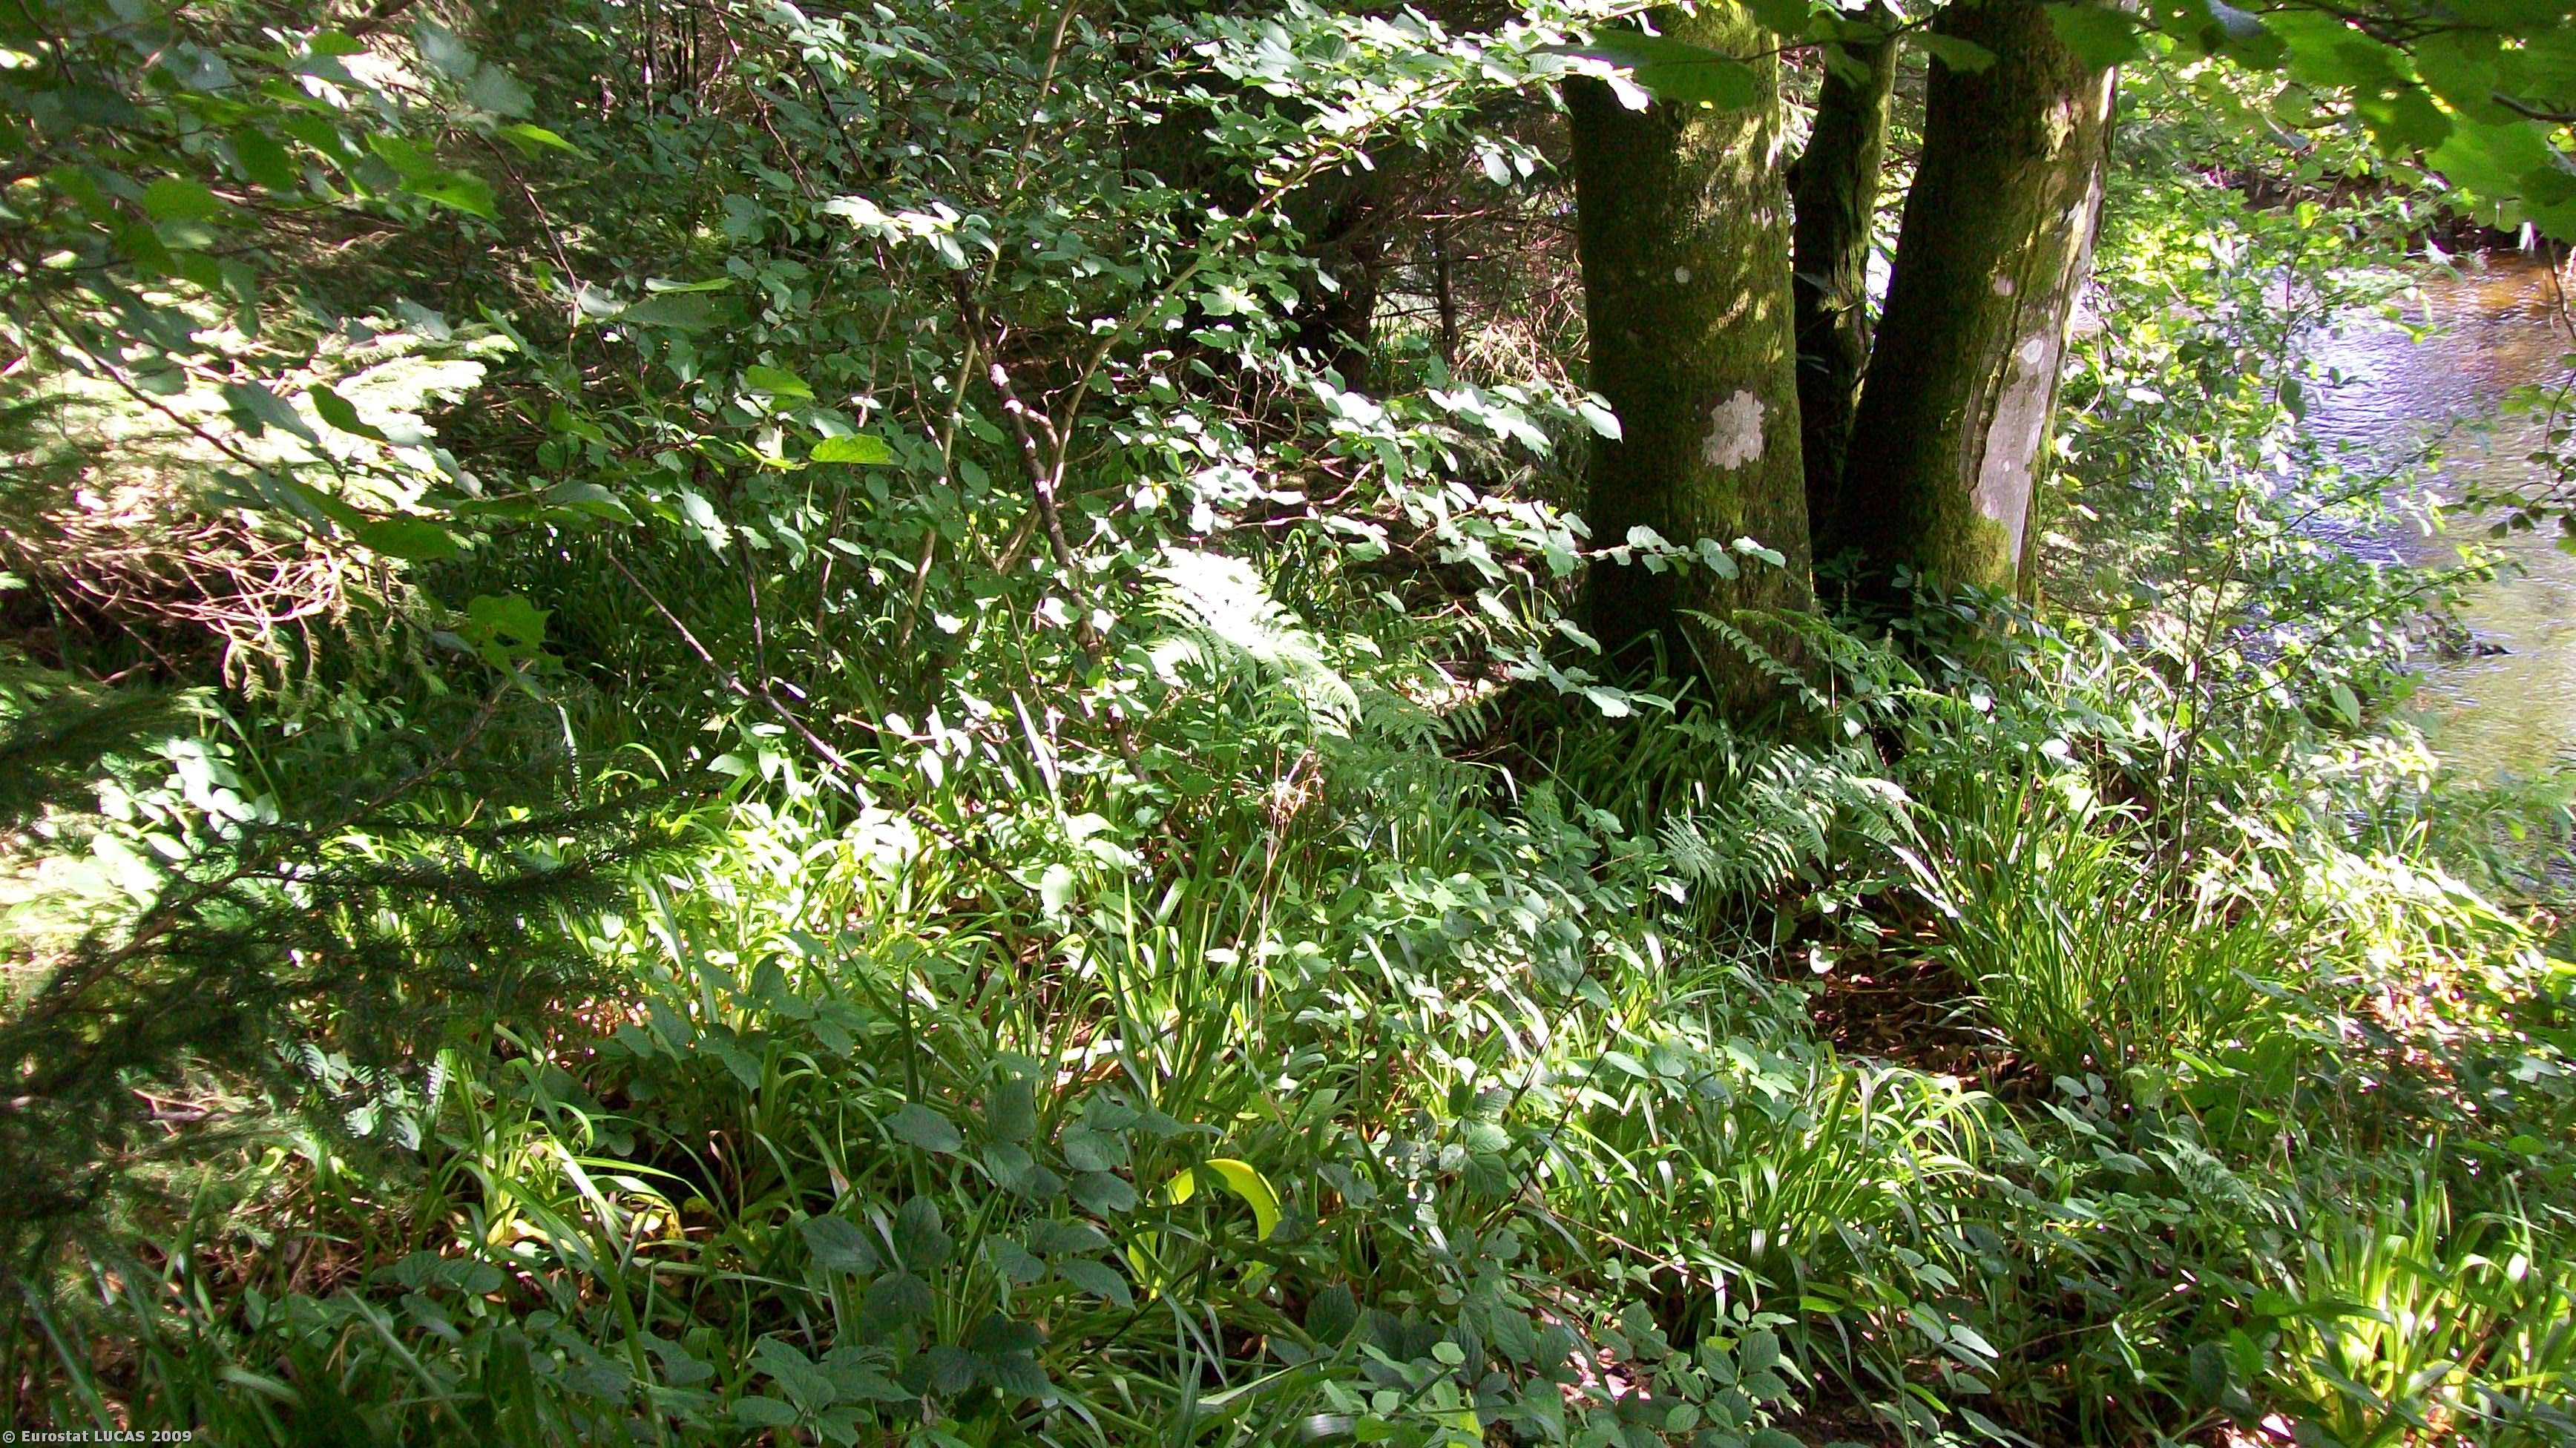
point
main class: Woodland
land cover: Mixed woodland
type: hemiboreal forest and nemoral coniferous forest and mixed broadleaved-coniferous forest
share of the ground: > 75 %
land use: Unused
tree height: > 5 m
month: August
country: GB
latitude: 55.3138
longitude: -3.4238
